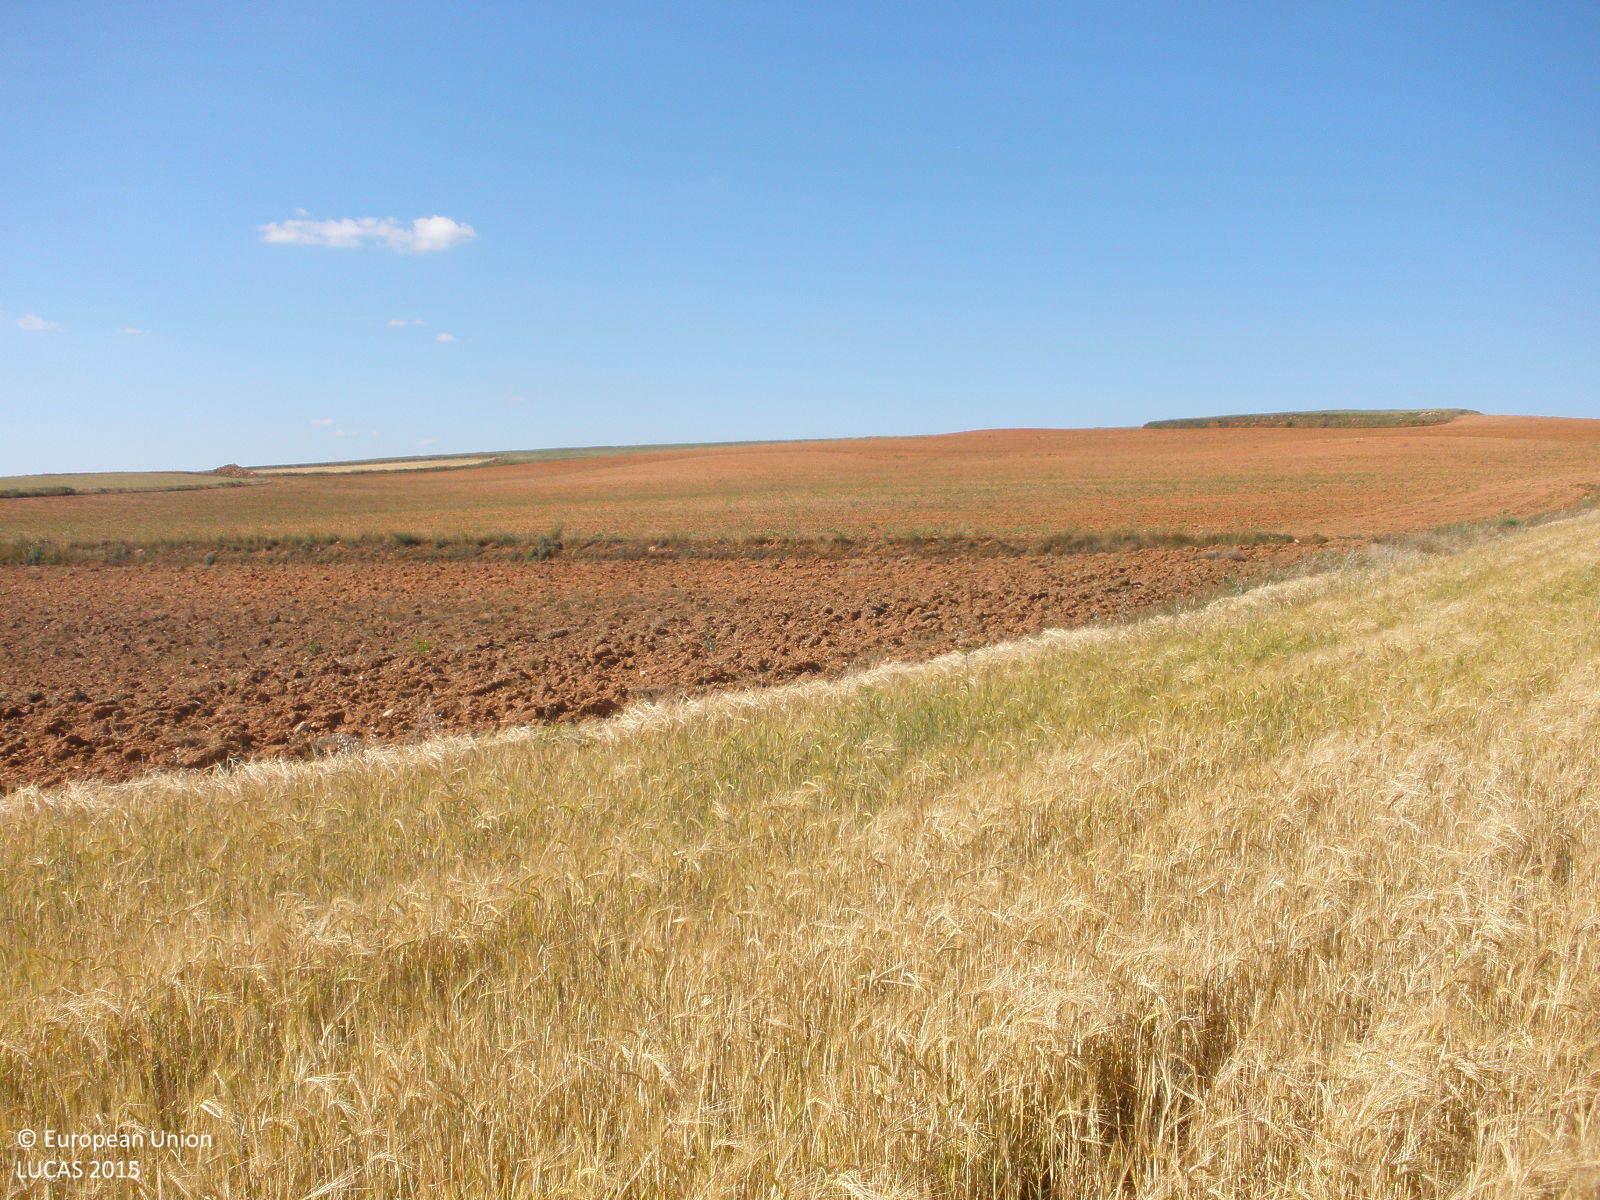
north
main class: Cropland
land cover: Barley
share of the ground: > 75 %
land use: Agriculture (excluding fallow land and kitchen gardens)
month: June
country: ES
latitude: 40.6217
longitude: -1.0898
